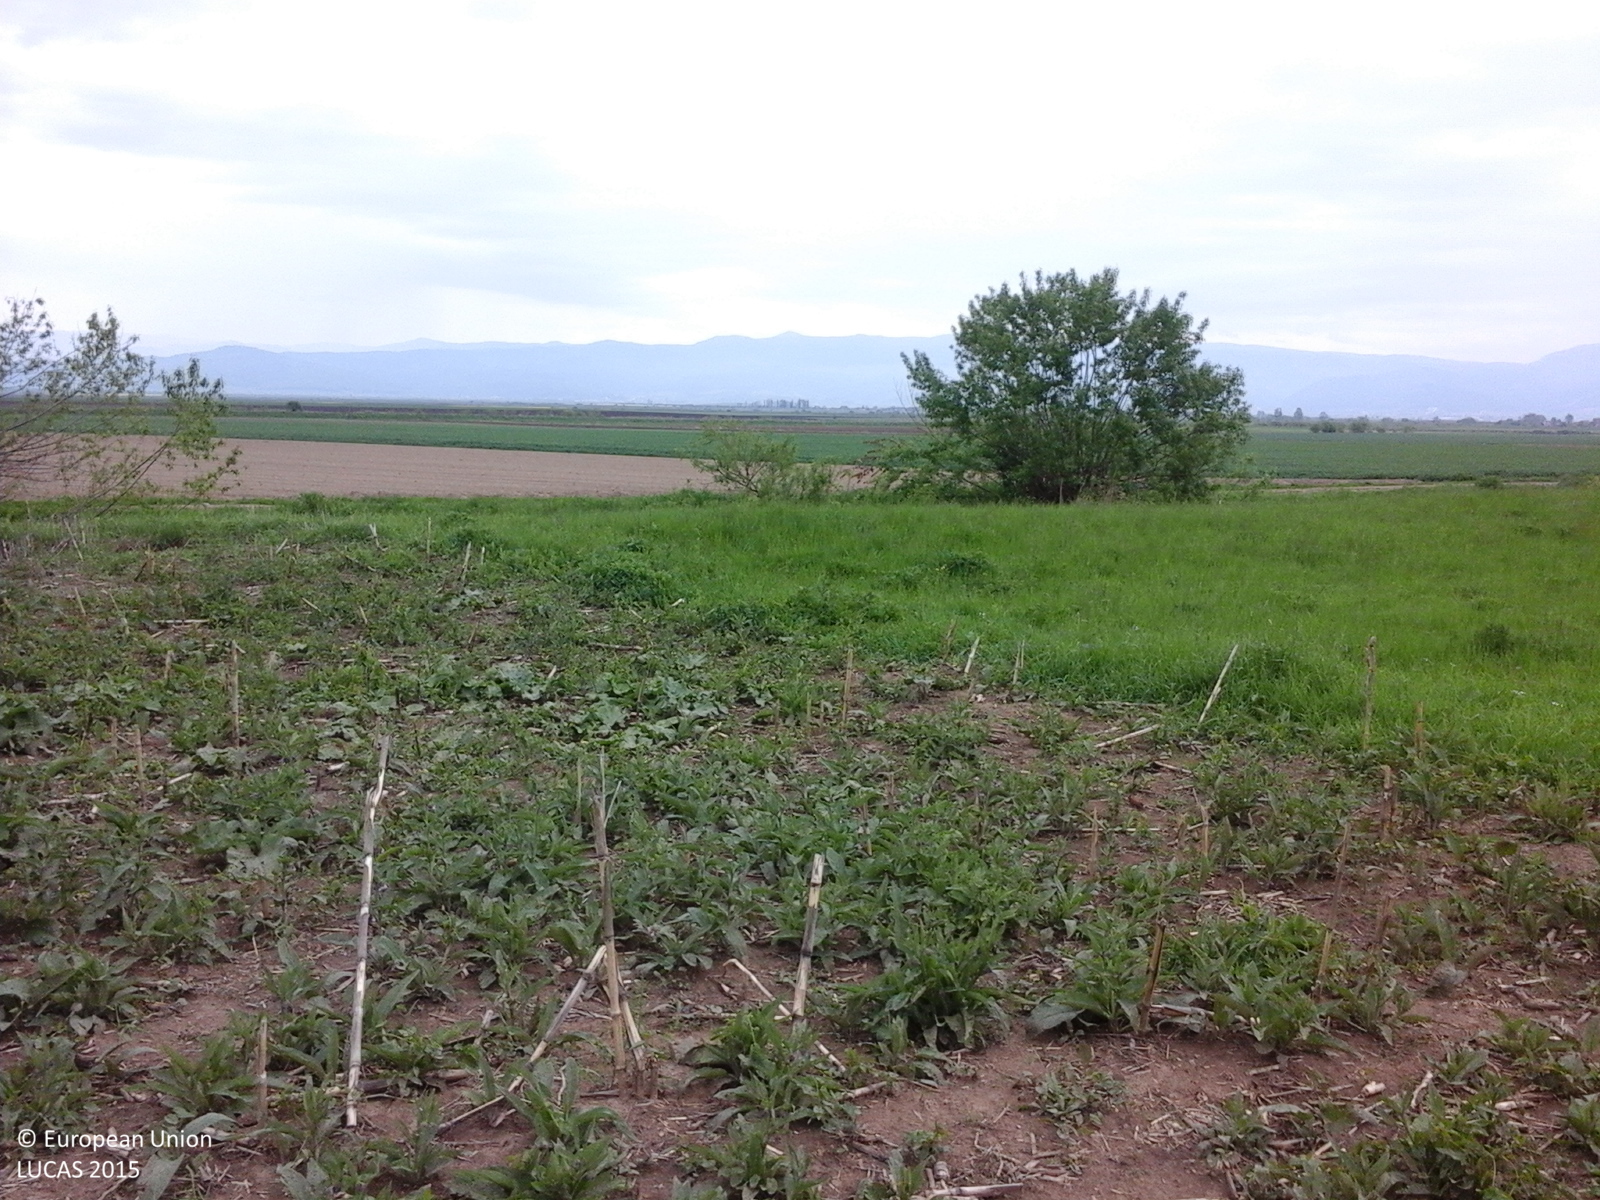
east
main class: Grassland
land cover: Spontaneously vegetated surfaces
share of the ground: 50 - 75 %
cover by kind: herbaceous plants 100 %
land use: Fallow land
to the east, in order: Spontaneously vegetated surfaces; Grassland with sparse tree/shrub cover; Ditches and canals; Grass margins; Tracks; Potatoes; Common wheat
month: May
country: RO
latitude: 45.8981
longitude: 26.0612
